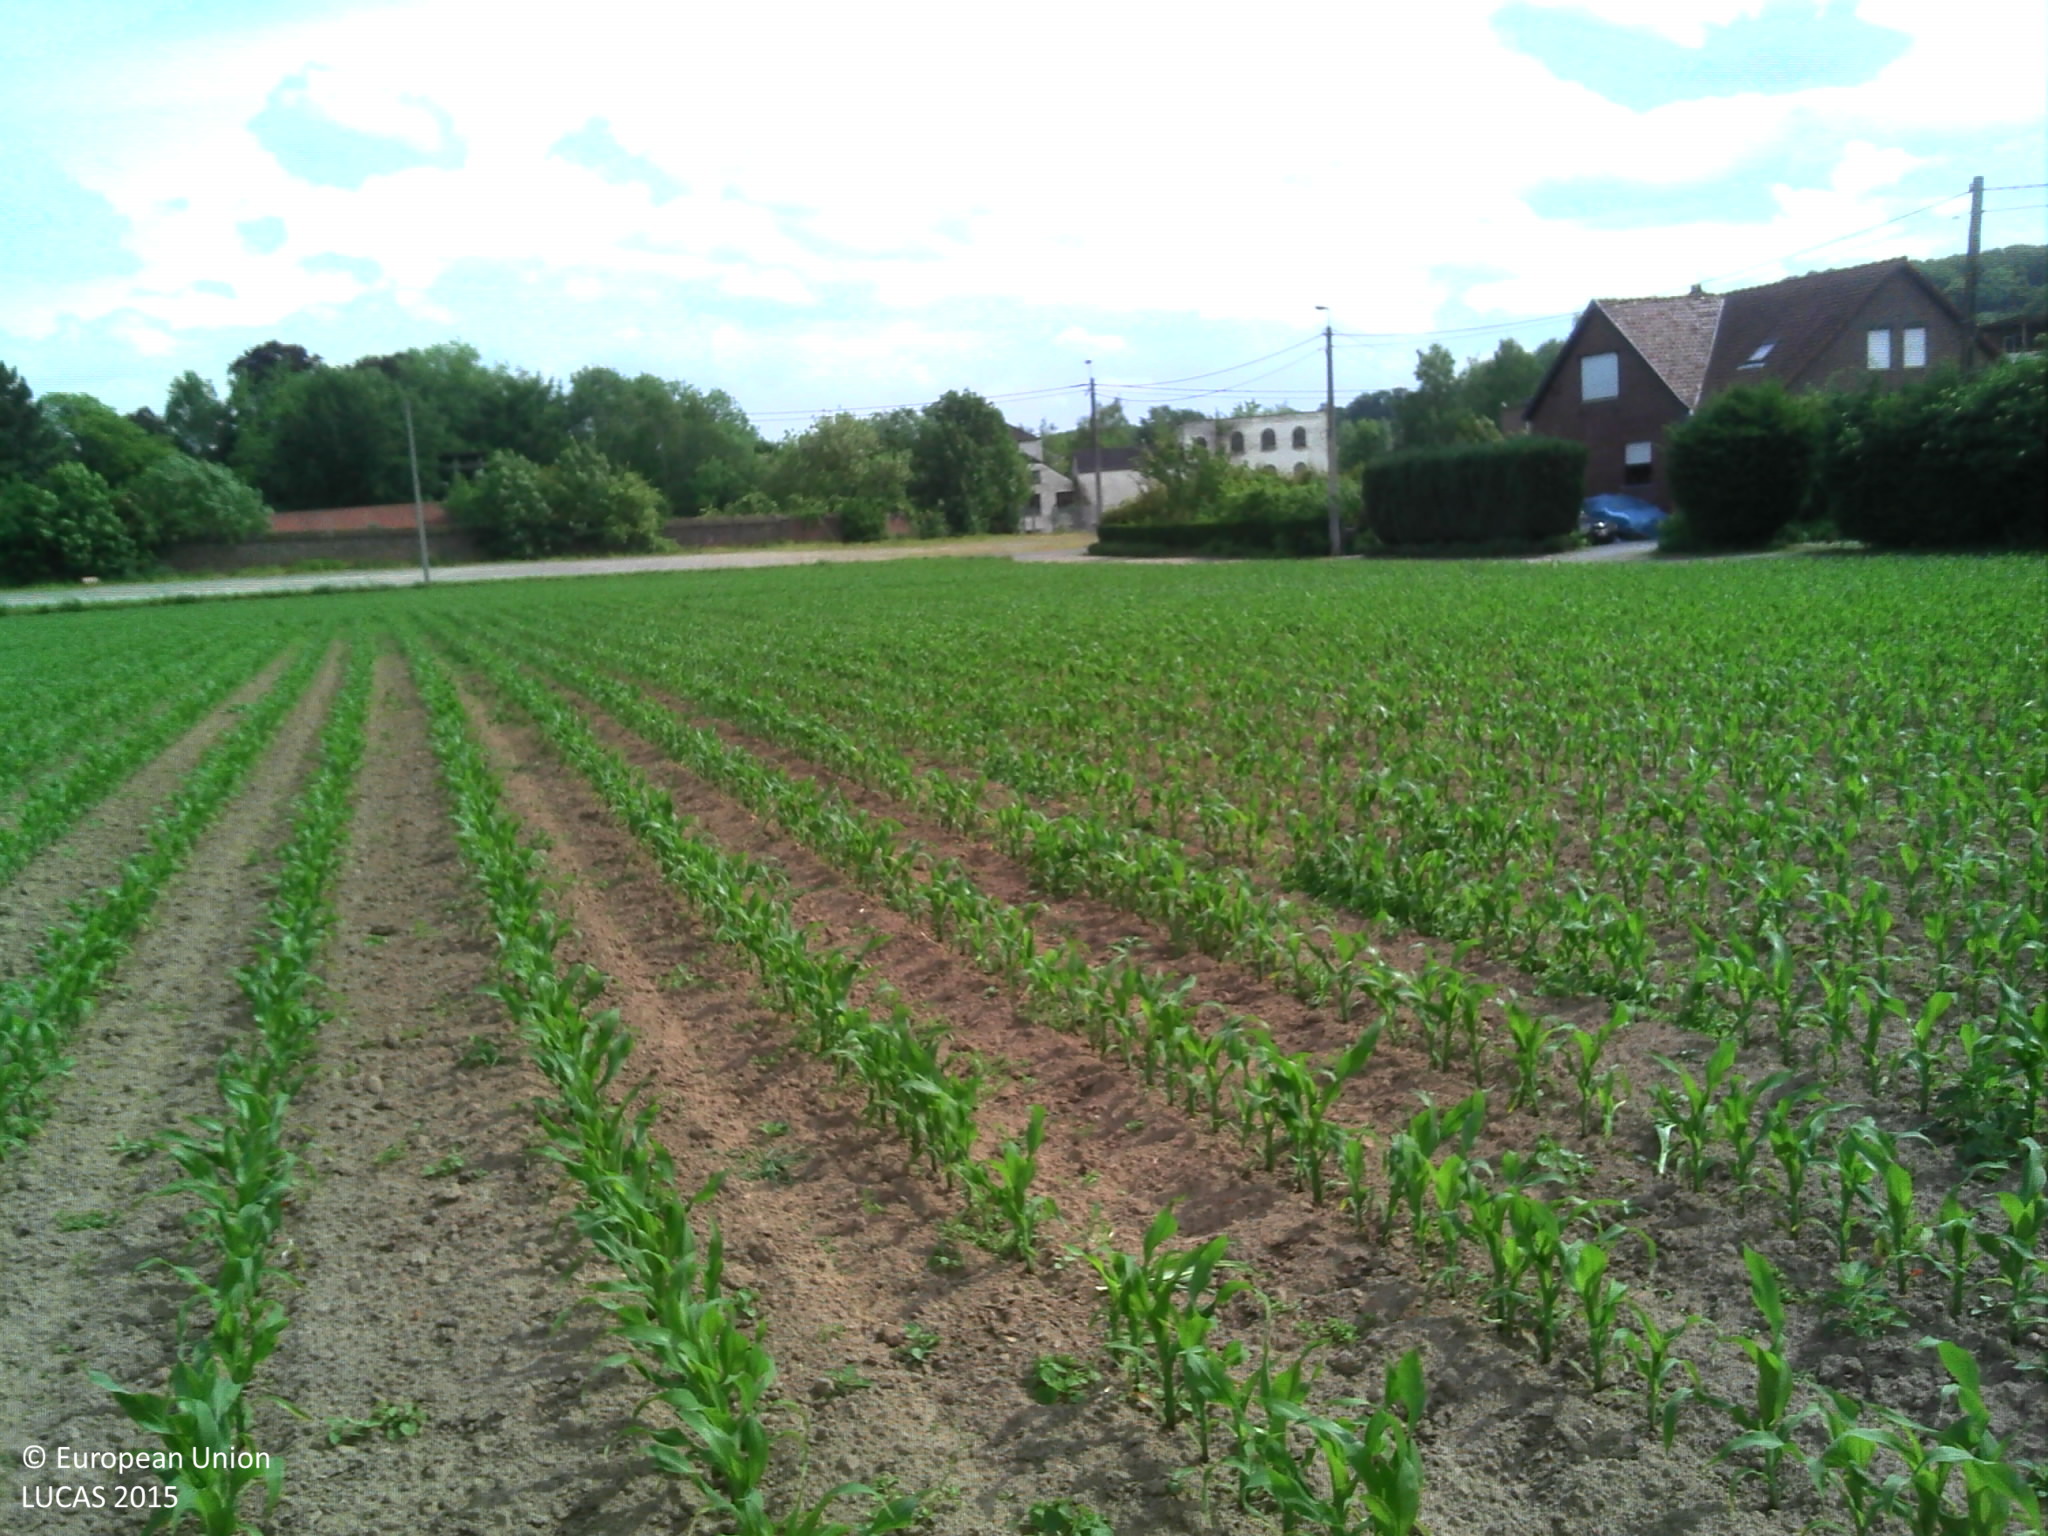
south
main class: Cropland
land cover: Maize
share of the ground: 25 - 50 %
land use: Agriculture (excluding fallow land and kitchen gardens)
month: May
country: BE
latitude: 50.7616
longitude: 4.6515
